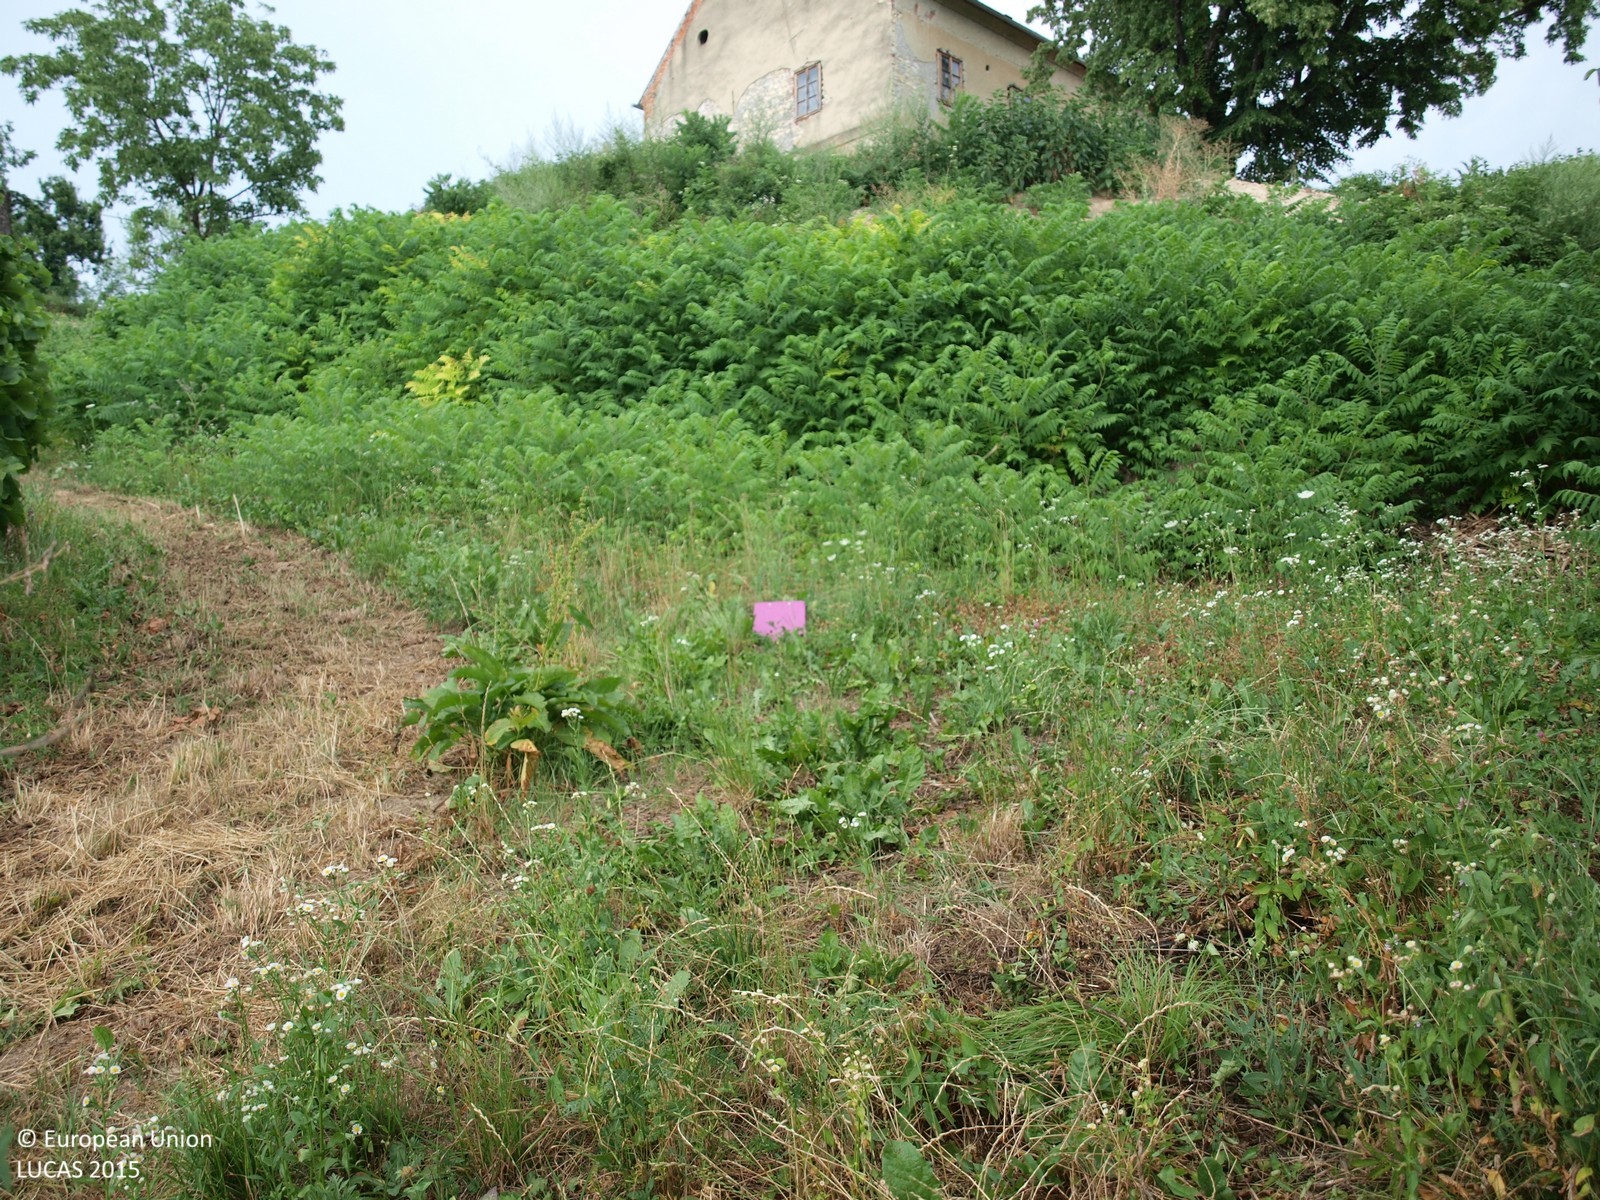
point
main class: Grassland
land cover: Grassland with sparse tree/shrub cover
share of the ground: > 75 %
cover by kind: herbaceous plants 95 %, broadleaved forest trees 5 %
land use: Agriculture (excluding fallow land and kitchen gardens)
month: July
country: HR
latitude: 45.9378
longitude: 16.1768
